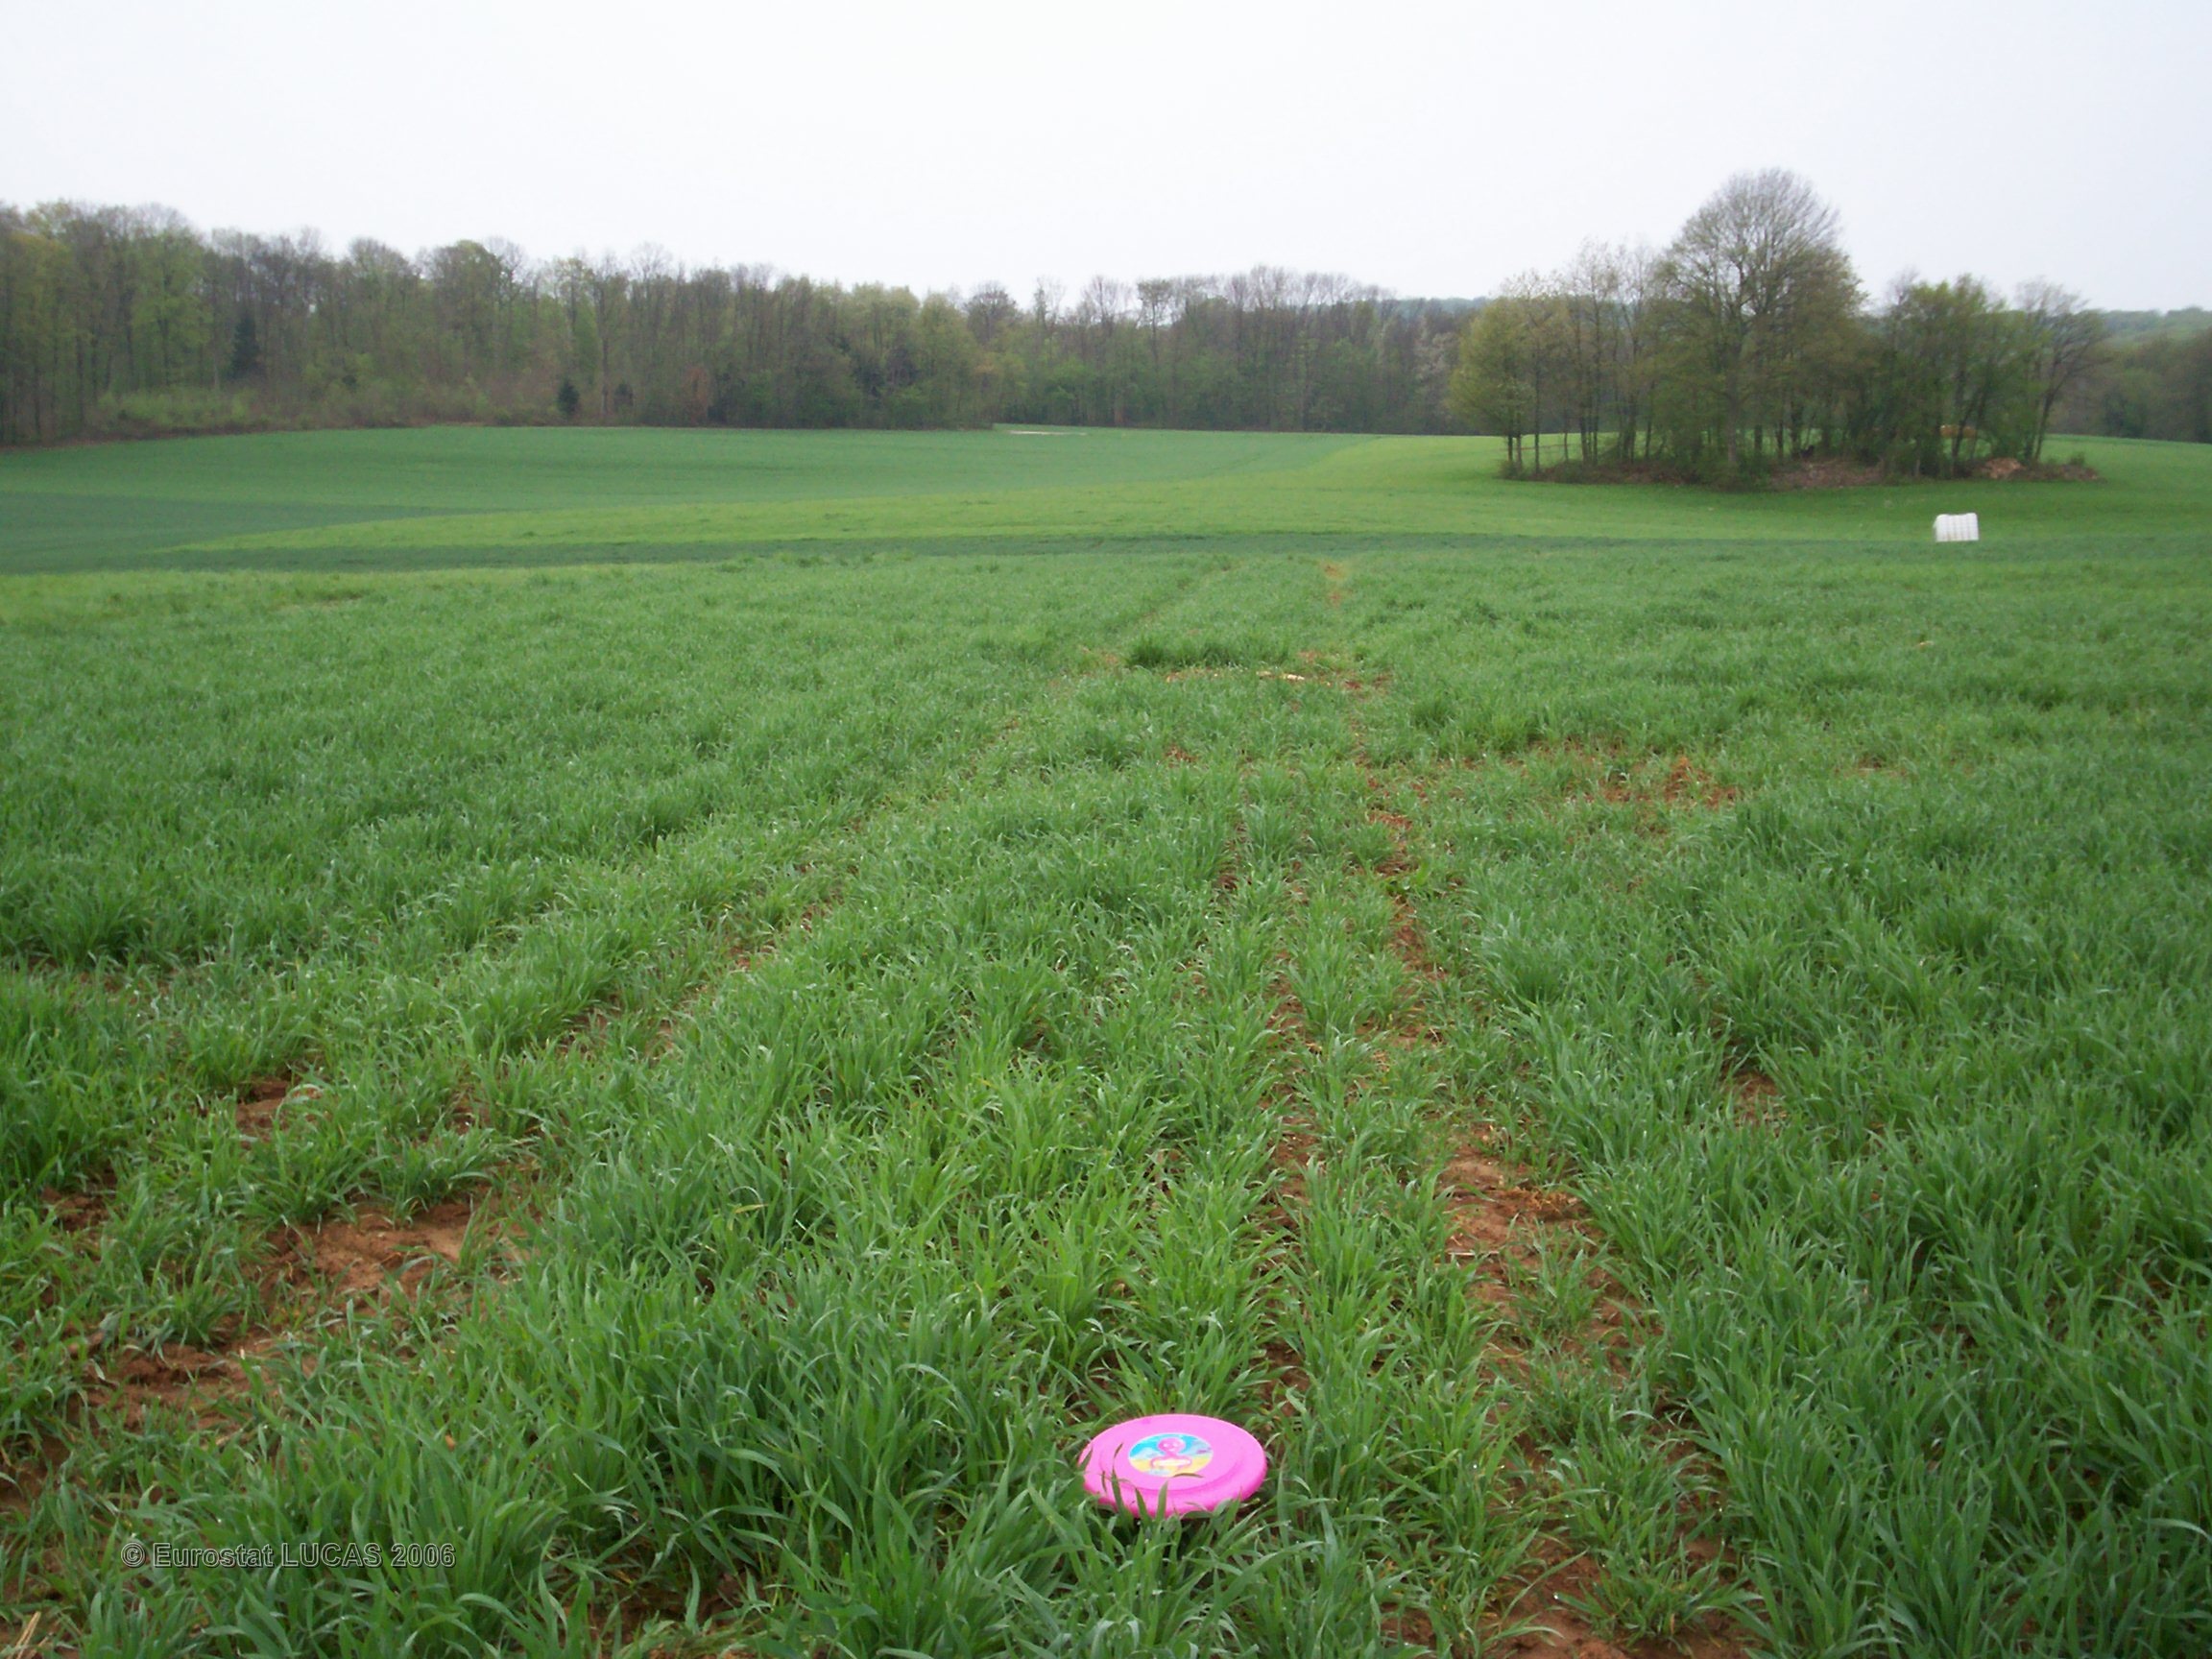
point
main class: Cropland
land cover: Common wheat
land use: Agriculture (excluding fallow land and kitchen gardens)
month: April
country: FR
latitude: 47.5054
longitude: 6.0848
